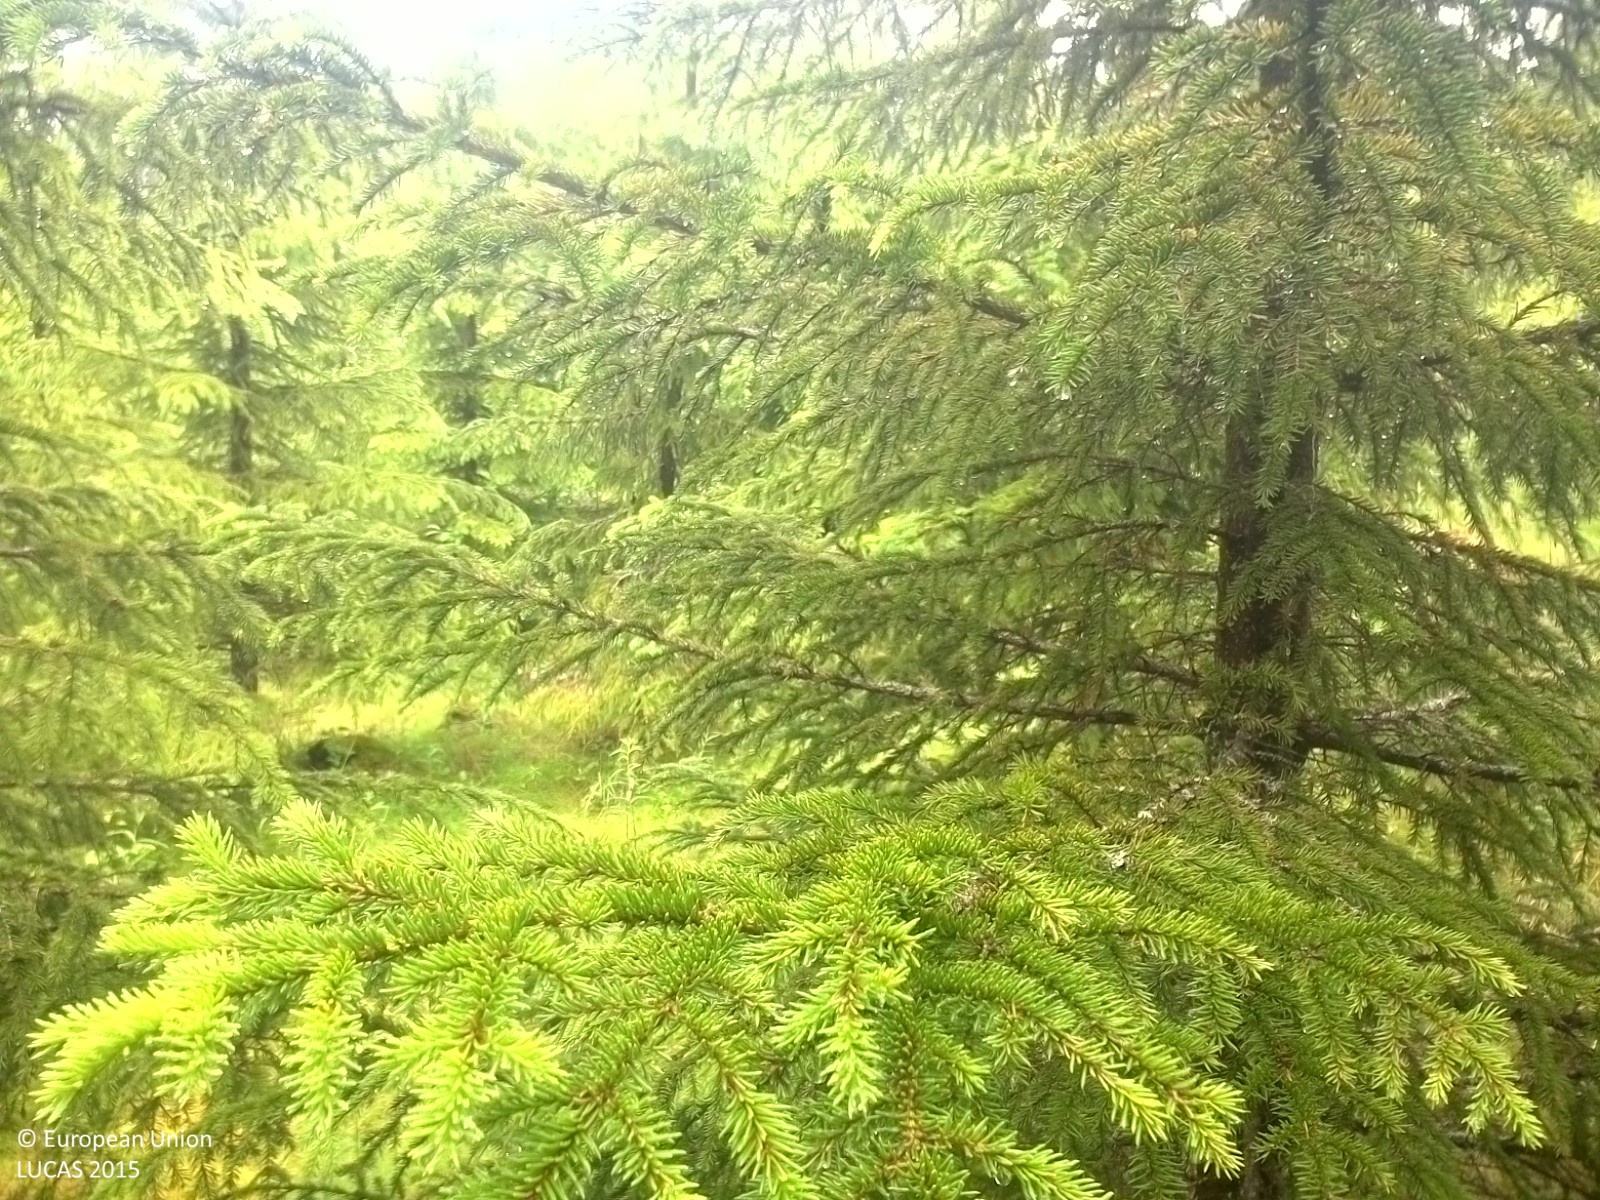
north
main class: Woodland
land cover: Spruce dominated coniferous woodland
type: boreal forest
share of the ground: 50 - 75 %
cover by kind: coniferous forest trees 65 %, herbaceous plants 35 %
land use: Forestry
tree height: < 5 m
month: July
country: SE
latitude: 62.4345
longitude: 16.9336
